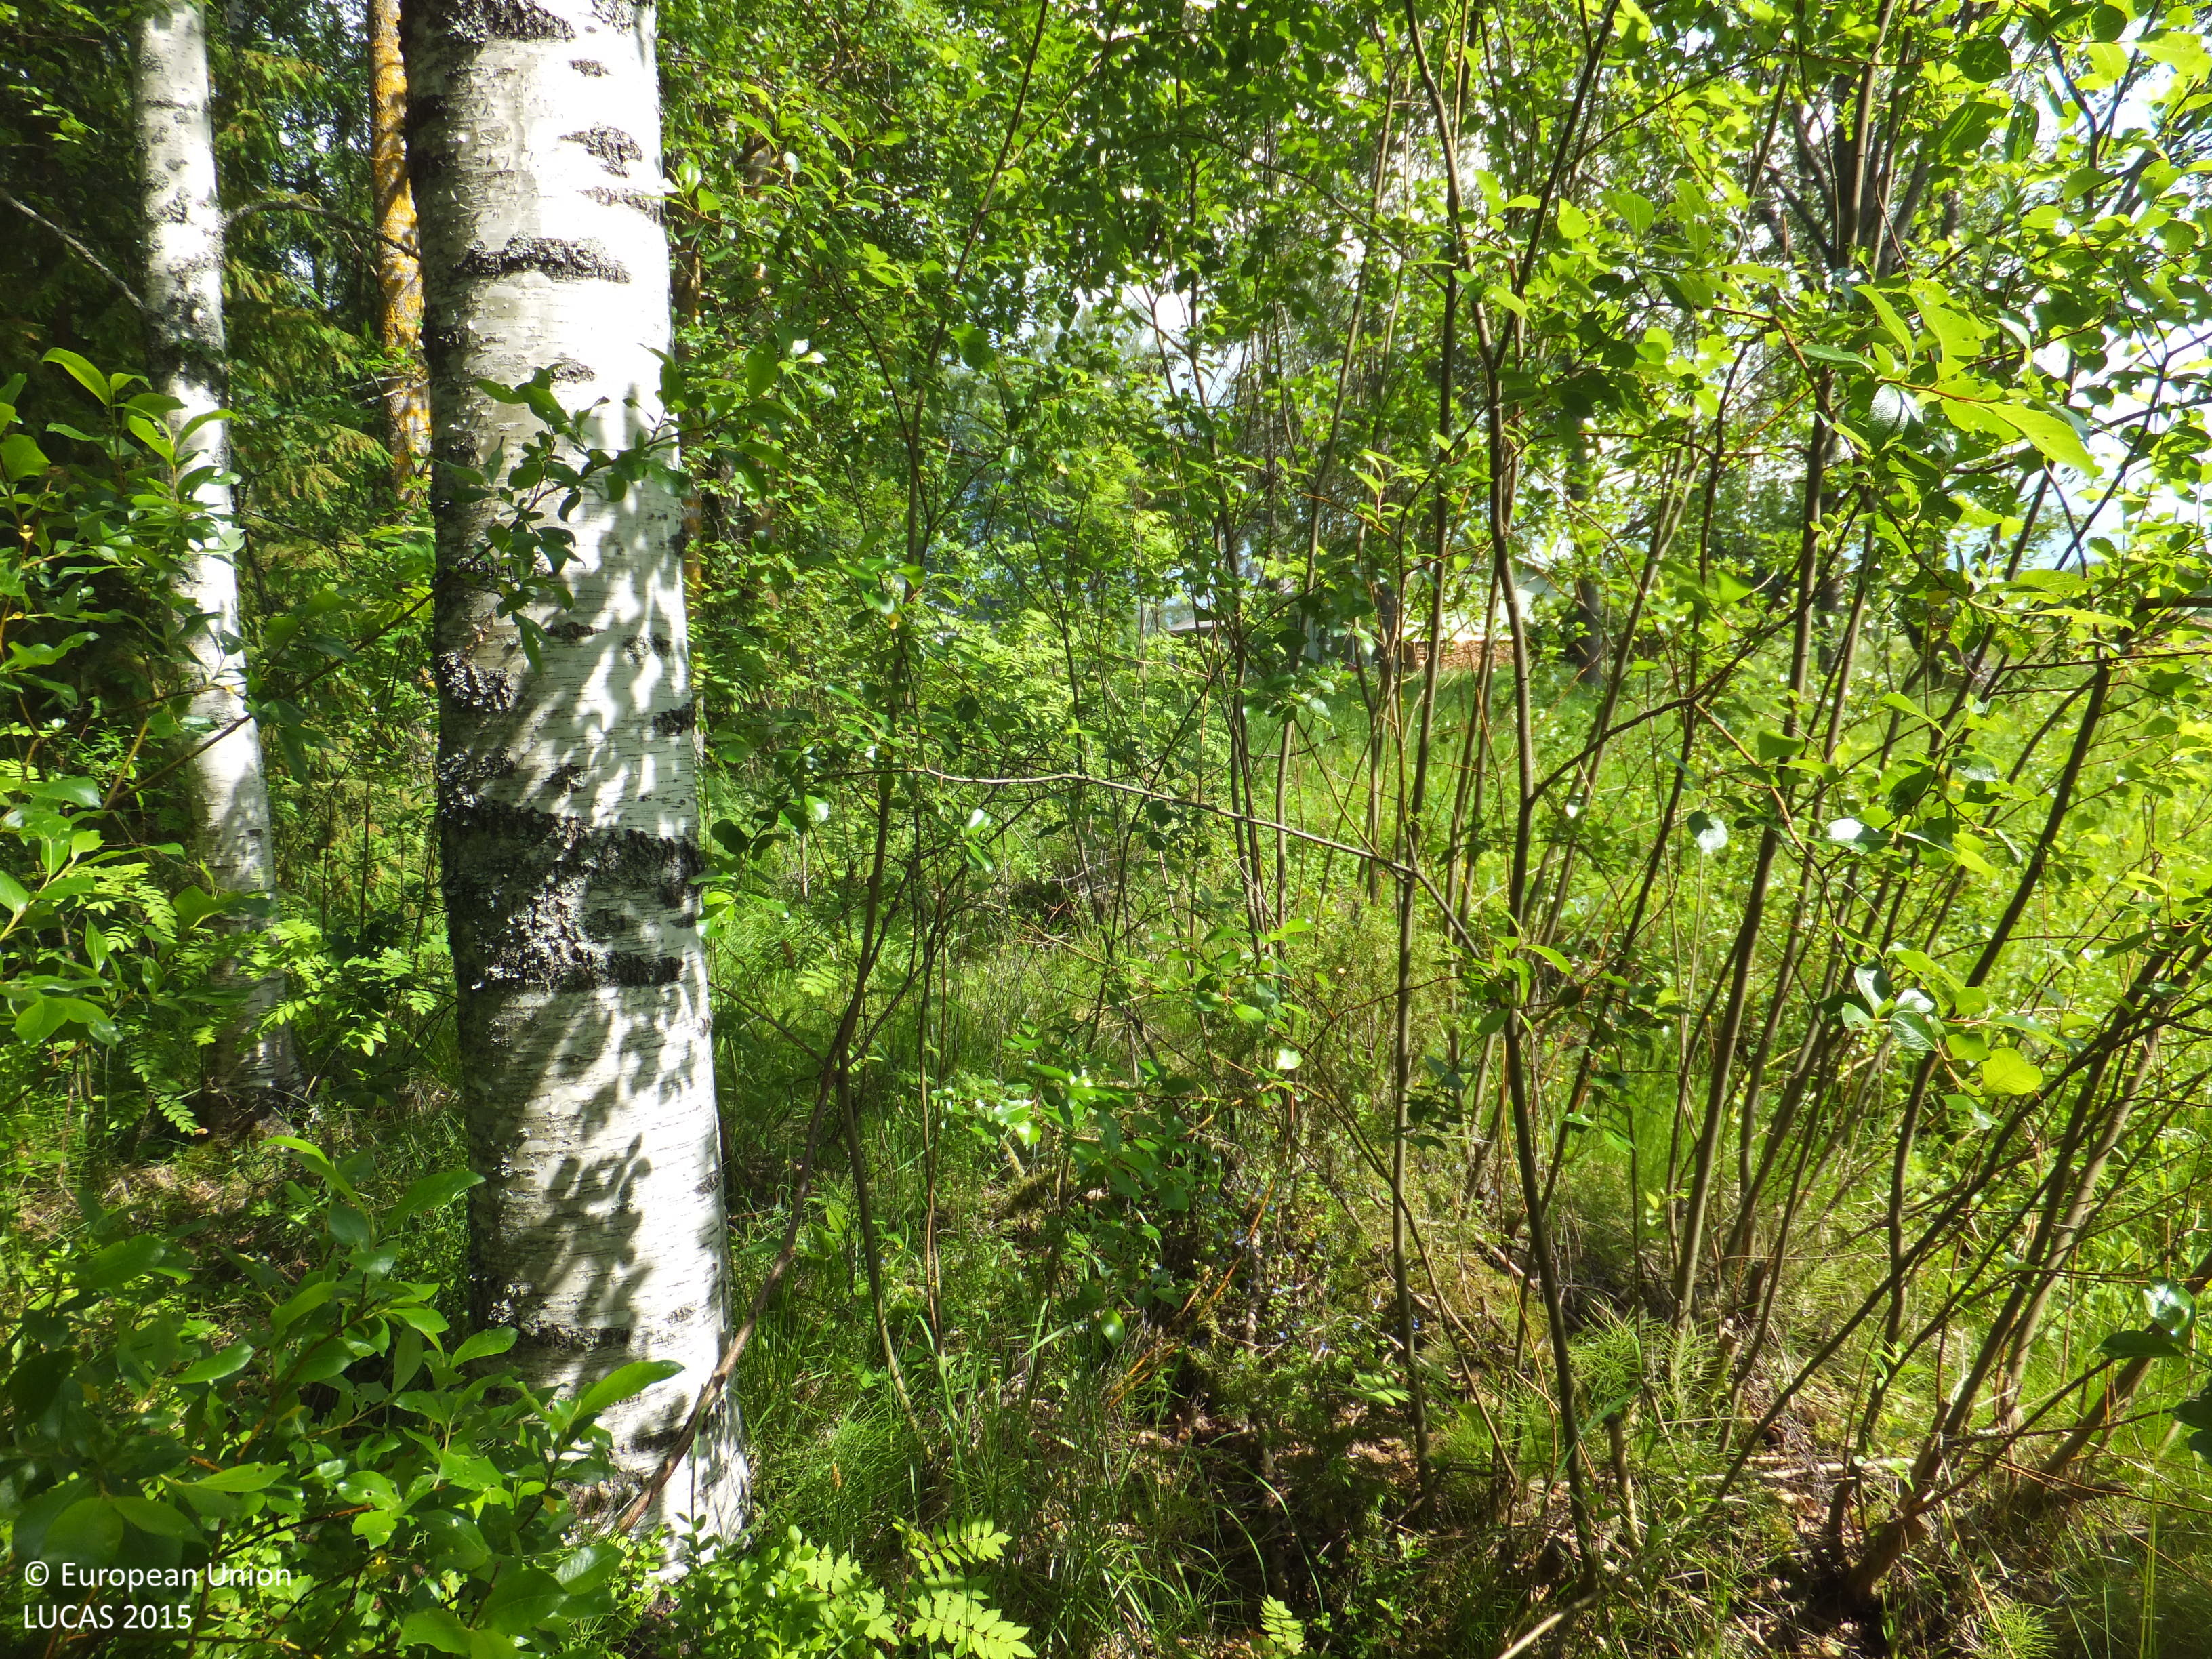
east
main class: Woodland
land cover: Spruce dominated mixed woodland
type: boreal forest
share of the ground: 50 - 75 %
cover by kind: broadleaved forest trees 40 %, herbaceous plants 25 %, coniferous forest trees 20 %, shrubs 15 %
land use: Residential
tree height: > 5 m
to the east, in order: Spruce dominated mixed woodland; Ditches and canals; Grassland with sparse tree/shrub cover; Artificial constructions in urban areas; Grassland with sparse tree/shrub cover; Ditches and canals; Barley; Electric lines; Barley; Shrubland with sparse tree cover
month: June
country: FI
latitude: 63.2096
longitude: 23.9329
